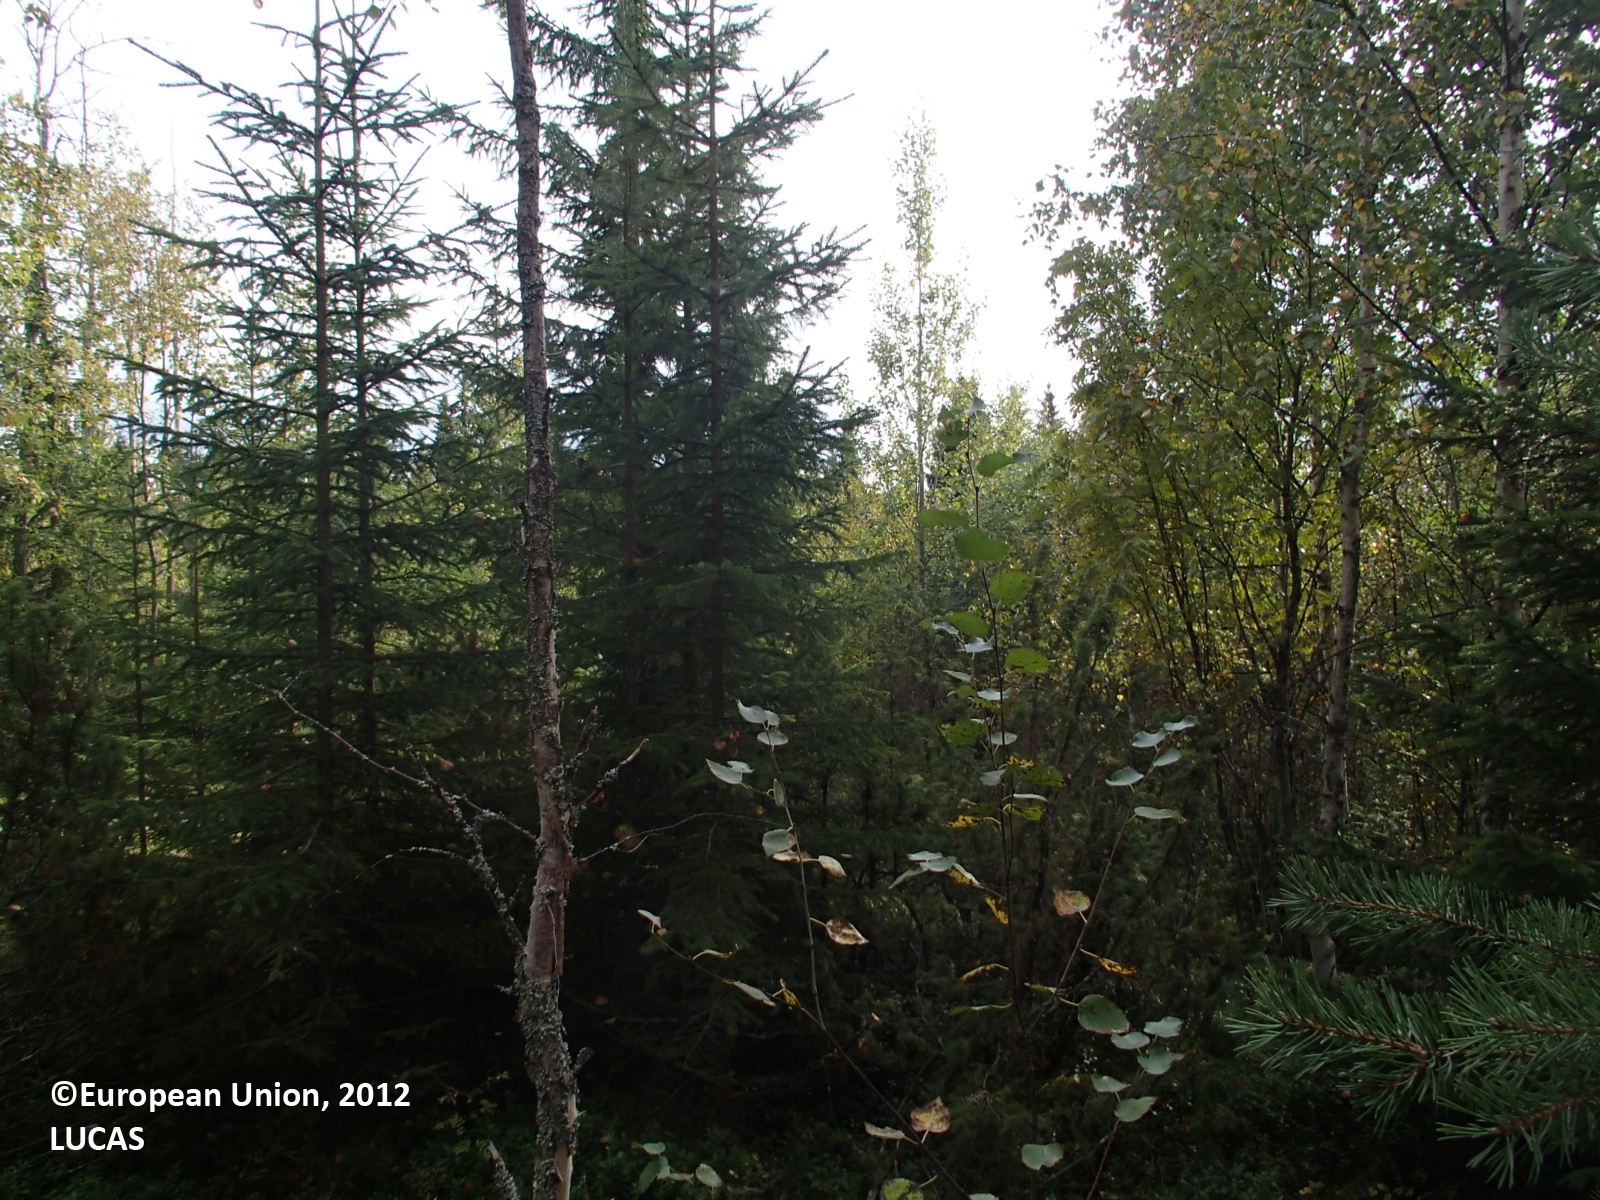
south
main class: Woodland
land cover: Spruce dominated mixed woodland
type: boreal forest
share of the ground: > 75 %
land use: Forestry
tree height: > 5 m
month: August
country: FI
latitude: 63.7380
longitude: 27.0953
